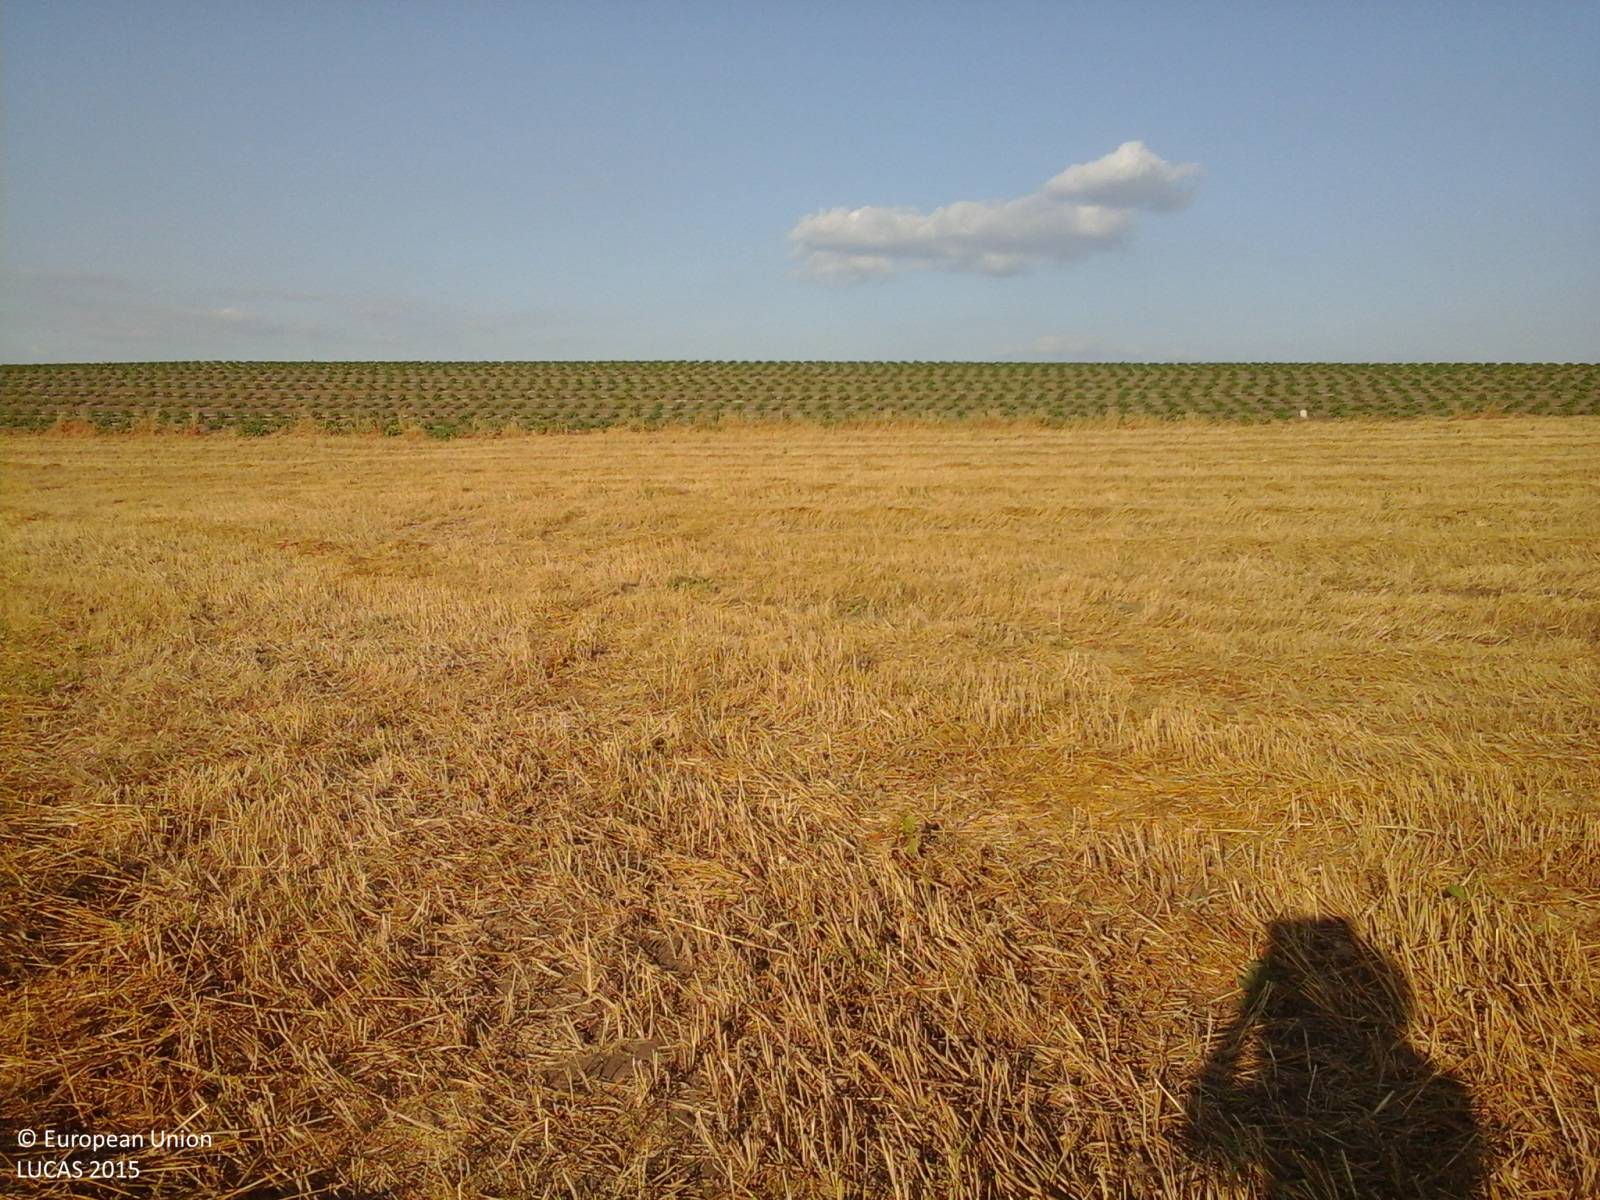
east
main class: Cropland
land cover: Dry pulses
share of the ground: > 75 %
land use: Agriculture (excluding fallow land and kitchen gardens)
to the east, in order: Dry pulses; Durum wheat; Ditches and canals; Durum wheat; Other fresh vegetables; Grass margins; Tracks; Durum wheat
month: July
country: IT
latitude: 37.8277
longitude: 12.9888
